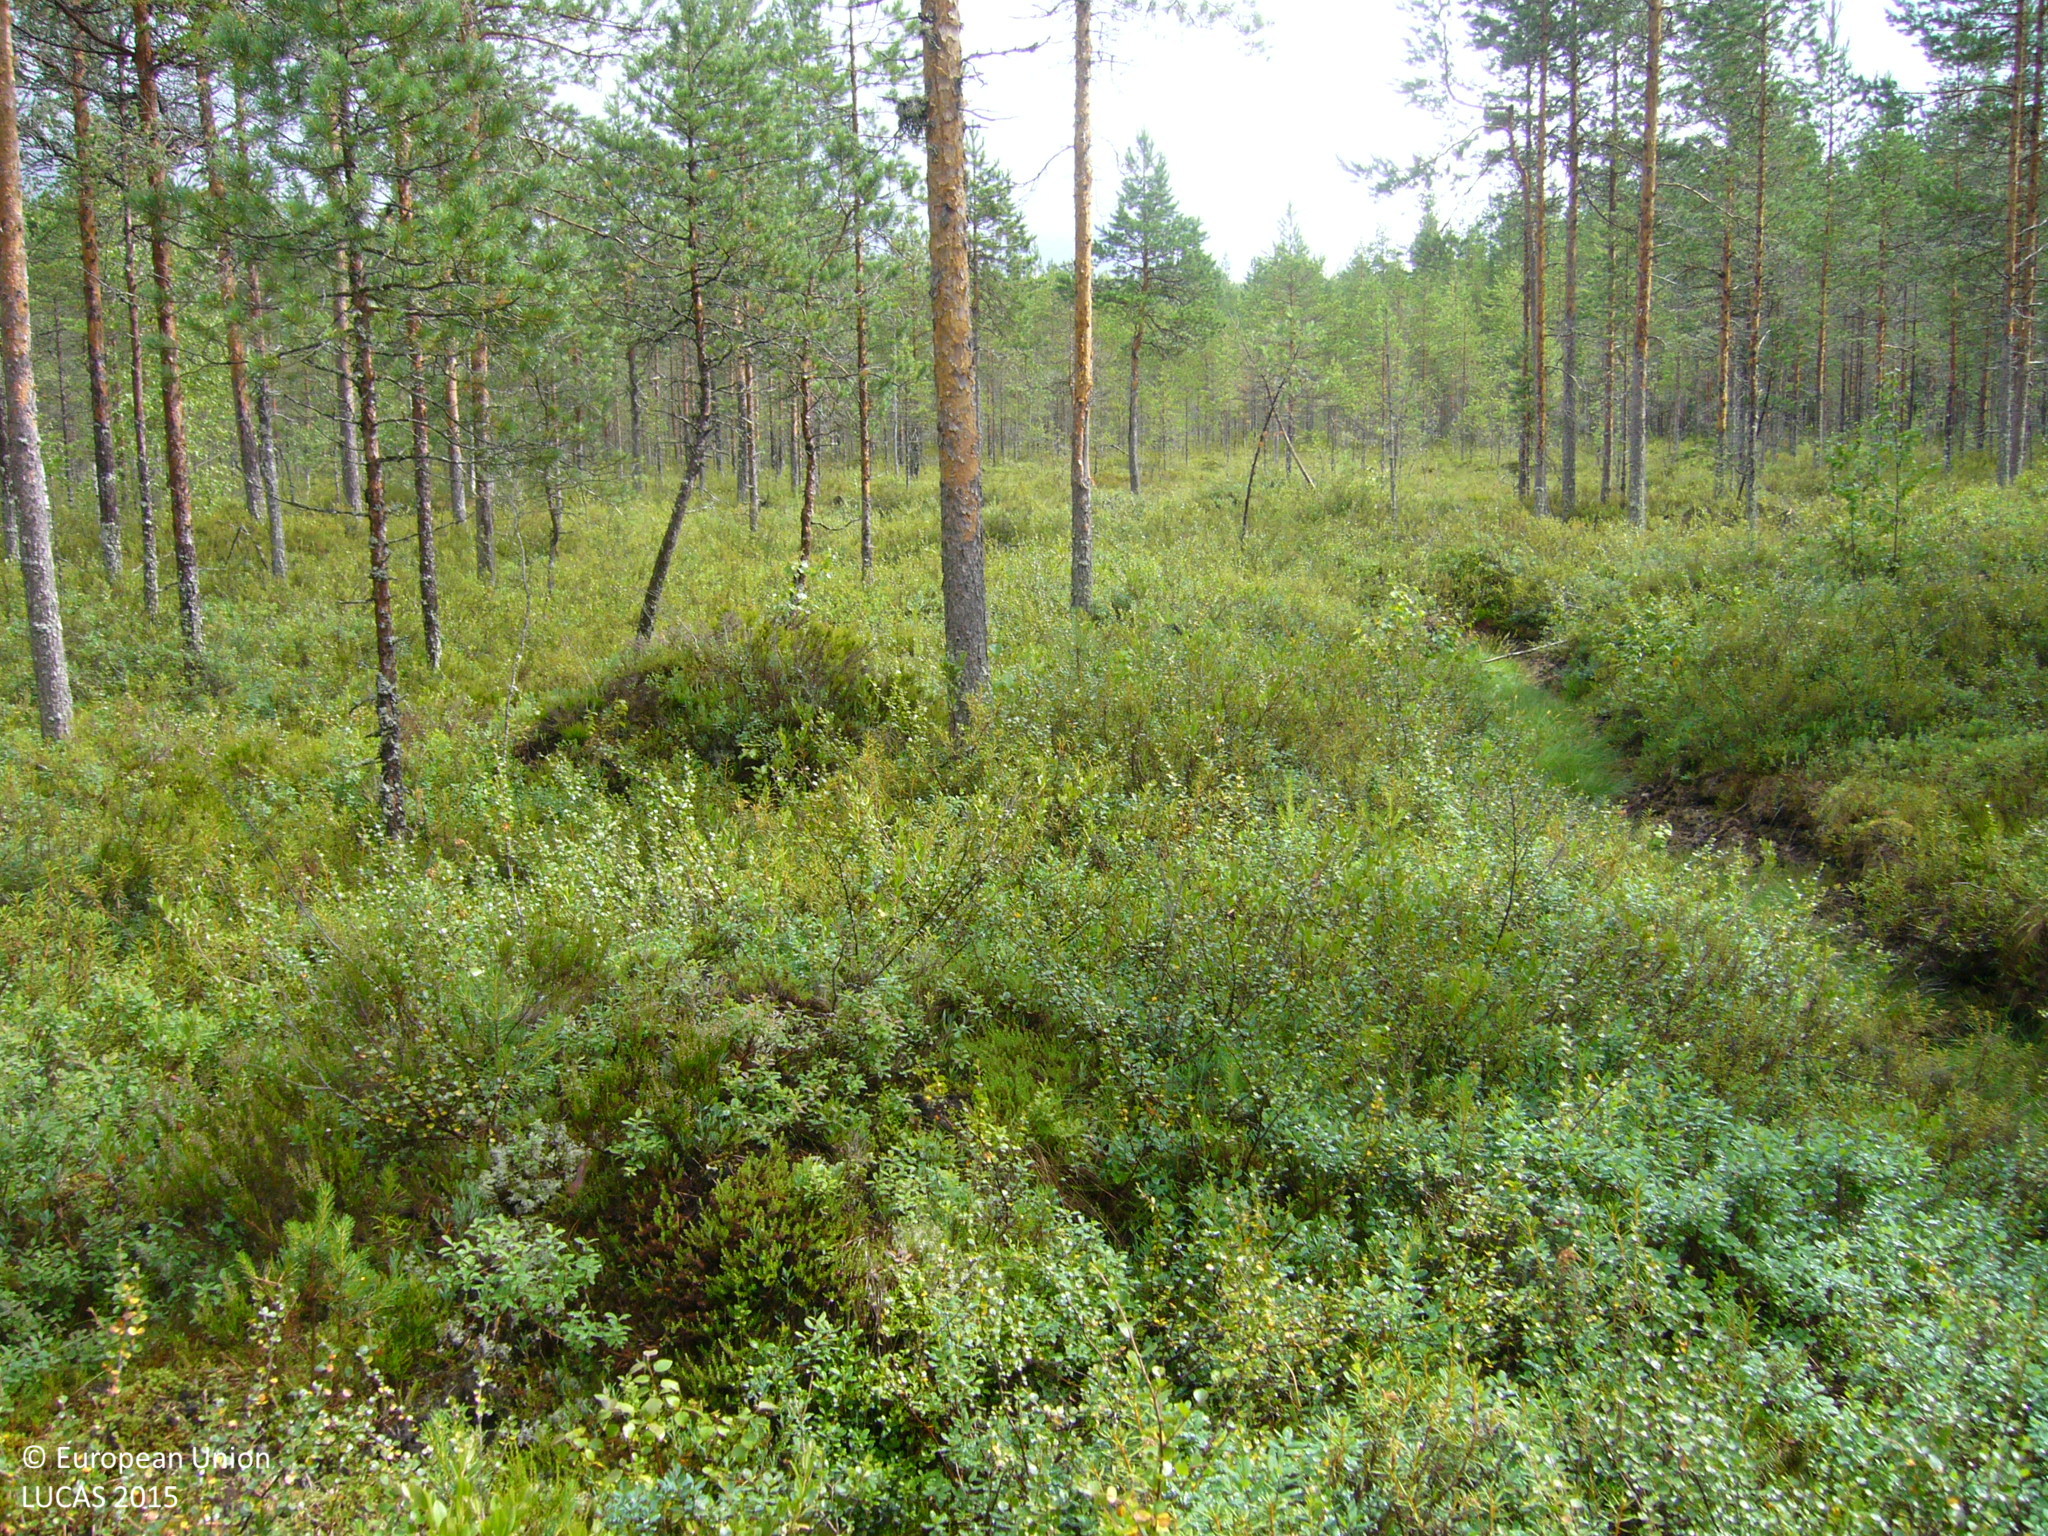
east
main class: Woodland
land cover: Pine dominated coniferous woodland
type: boreal forest
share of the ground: 50 - 75 %
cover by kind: coniferous forest trees 60 %, shrubs 40 %
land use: Forestry
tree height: > 5 m
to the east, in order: Pine dominated coniferous woodland; Ditches and canals; Pine dominated coniferous woodland; Ditches and canals; Pine dominated coniferous woodland; Pine dominated mixed woodland; Ditches and canals; Pine dominated mixed woodland; Ditches and canals; Pine dominated mixed woodland; Other mixed woodland; Ditches and canals; Grass margins; Tracks; Grass margins; Ditches and canals
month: July
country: FI
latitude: 63.7998
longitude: 26.0058
